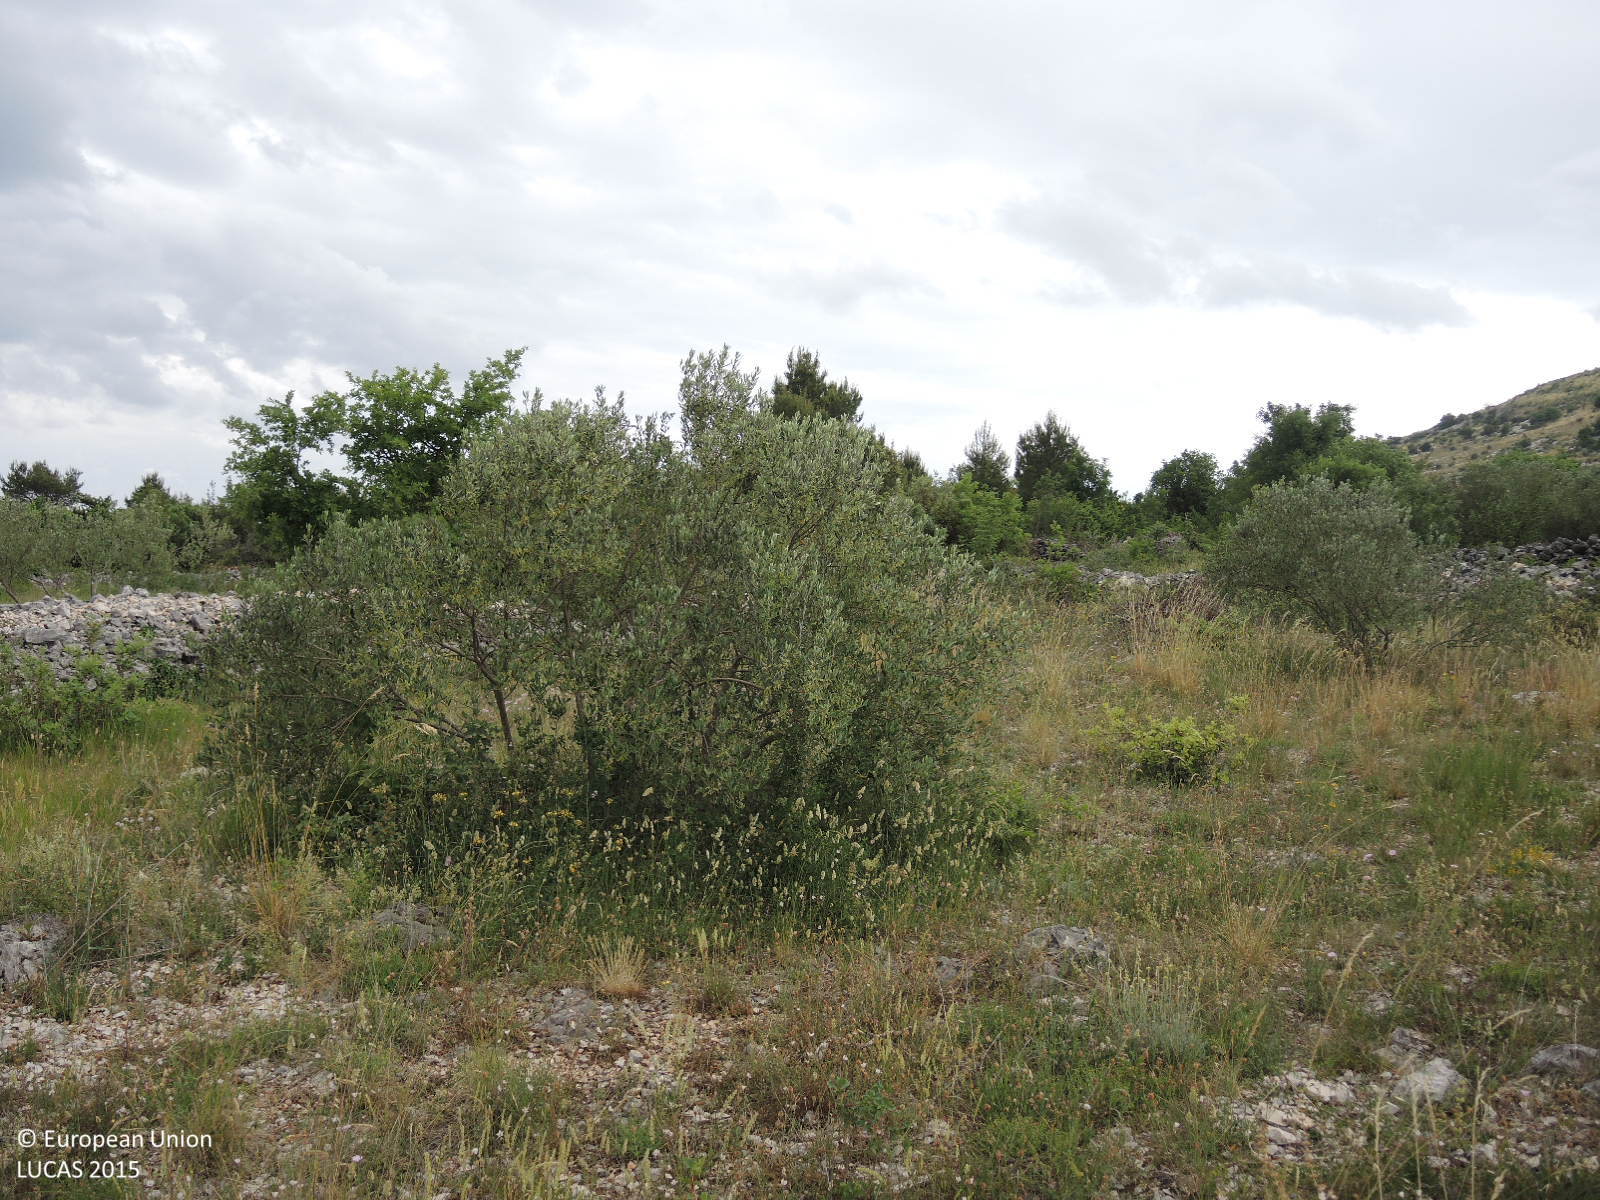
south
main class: Cropland
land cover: Olive groves
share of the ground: 10 - 25 %
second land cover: Spontaneously vegetated surfaces
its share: > 75 %
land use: Agriculture (excluding fallow land and kitchen gardens)
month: May
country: HR
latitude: 43.8088
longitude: 15.7965
